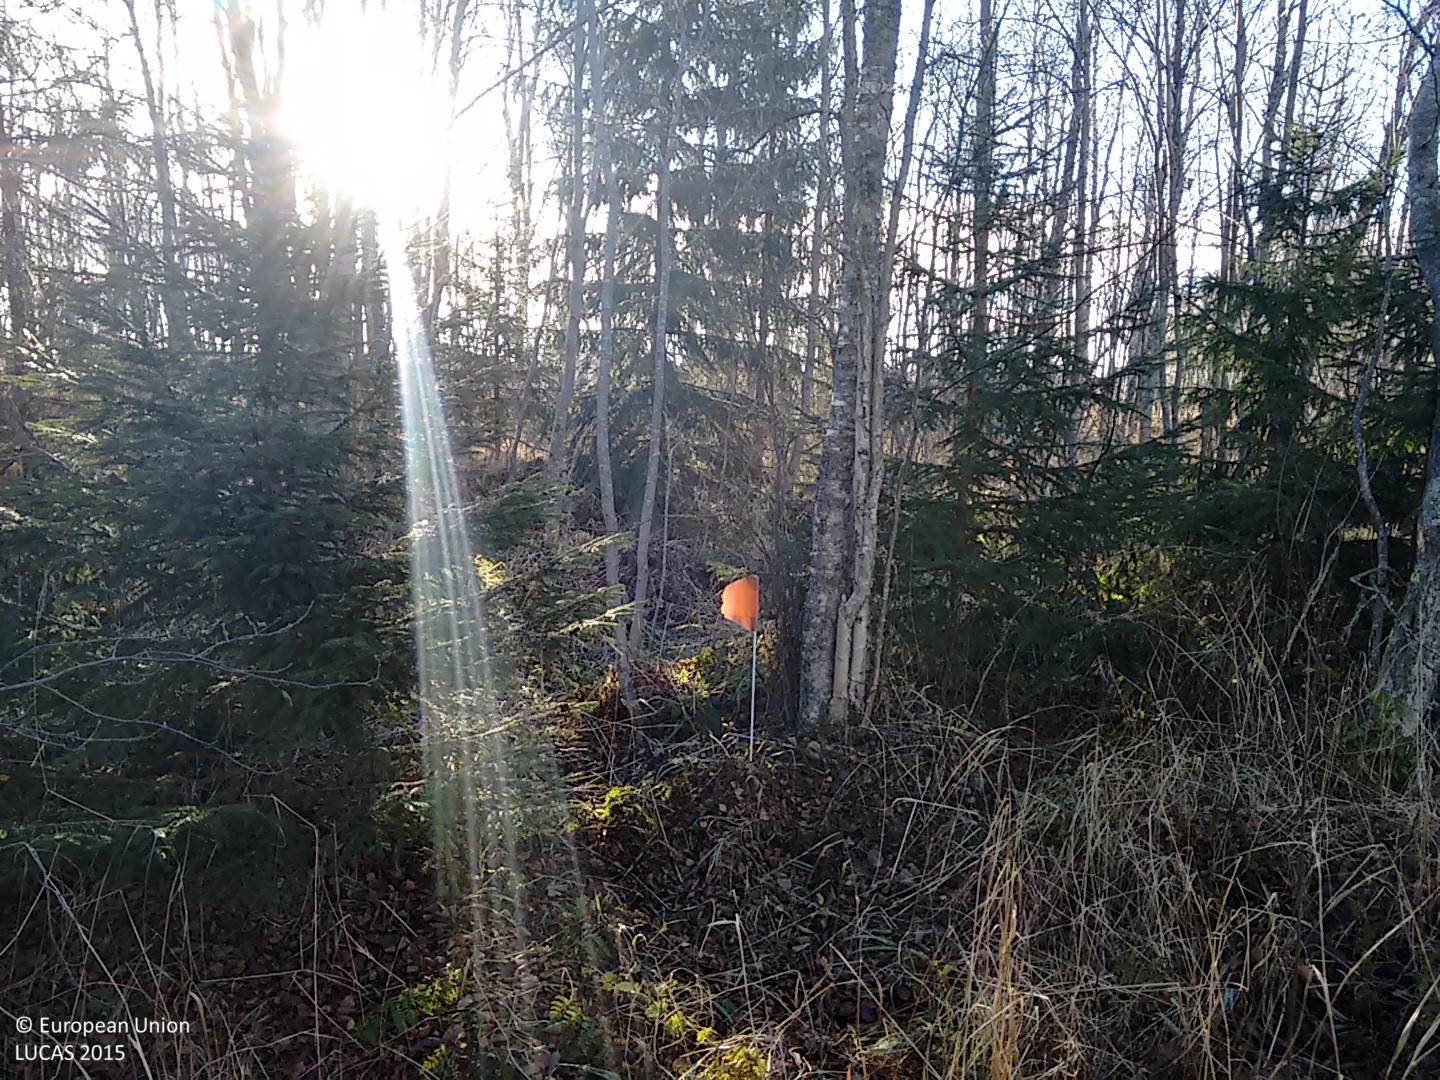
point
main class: Woodland
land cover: Spruce dominated mixed woodland
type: boreal forest
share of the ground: > 75 %
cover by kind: coniferous forest trees 45 %, broadleaved forest trees 40 %, herbaceous plants 10 %, shrubs 5 %
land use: Forestry
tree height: > 5 m
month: October
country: FI
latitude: 64.7656
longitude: 24.6375
